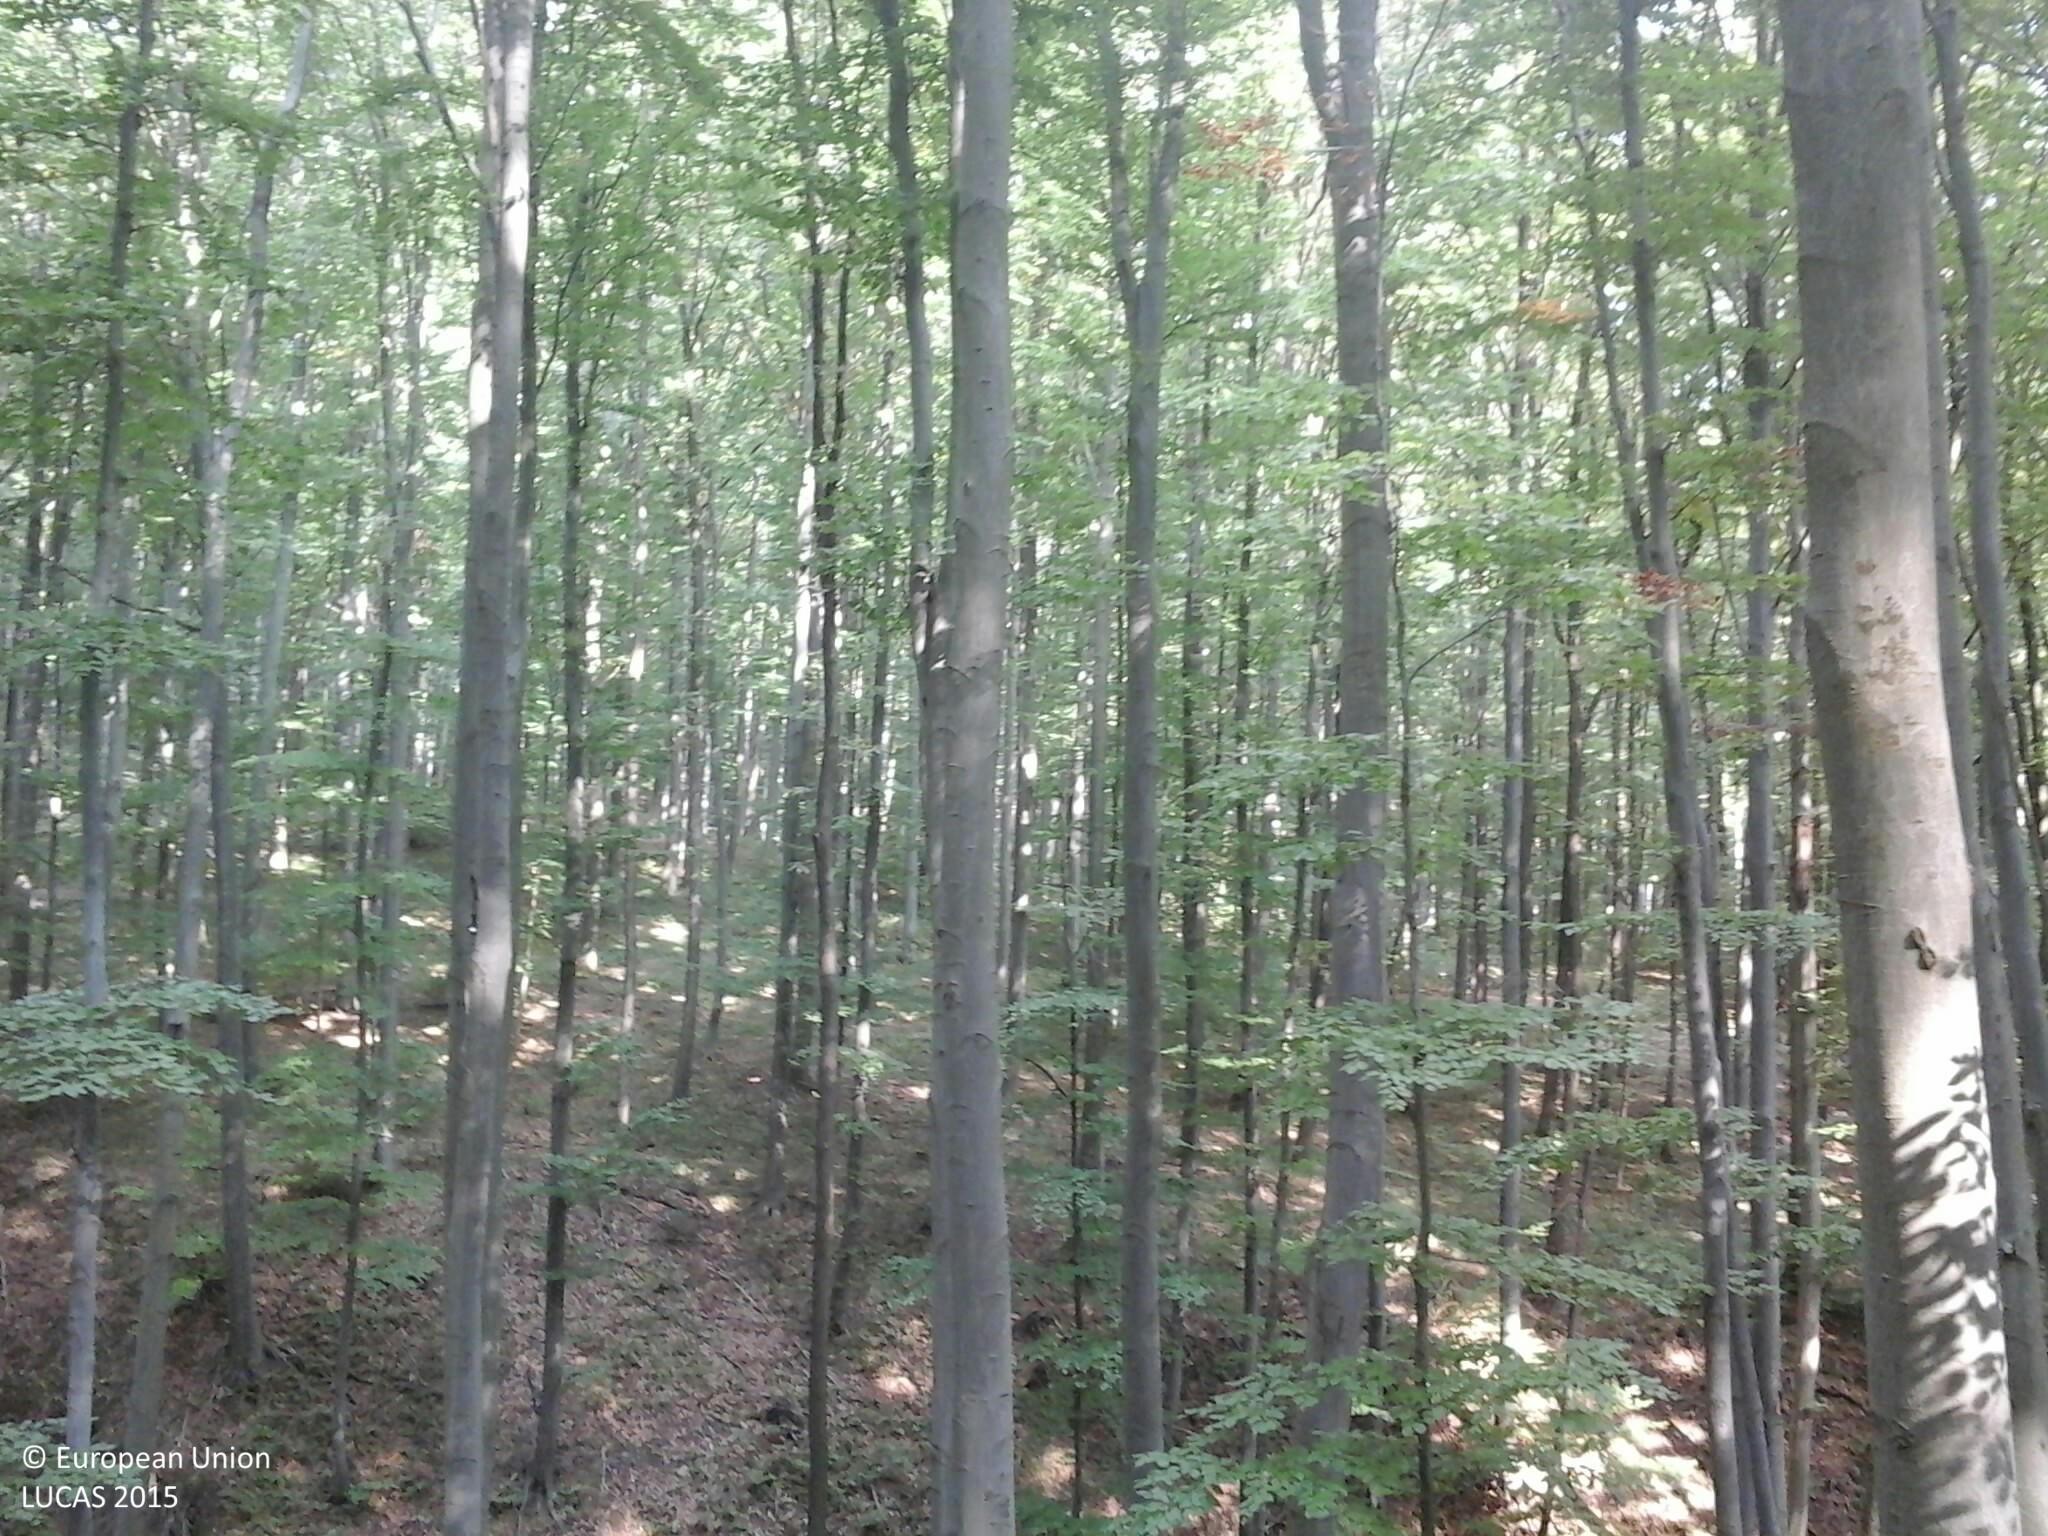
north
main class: Woodland
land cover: Broadleaved woodland
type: beech forest
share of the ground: > 75 %
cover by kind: broadleaved forest trees 95 %, herbaceous plants 5 %
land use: Forestry
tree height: > 5 m
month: September
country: HU
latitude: 47.9156
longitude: 19.9693
